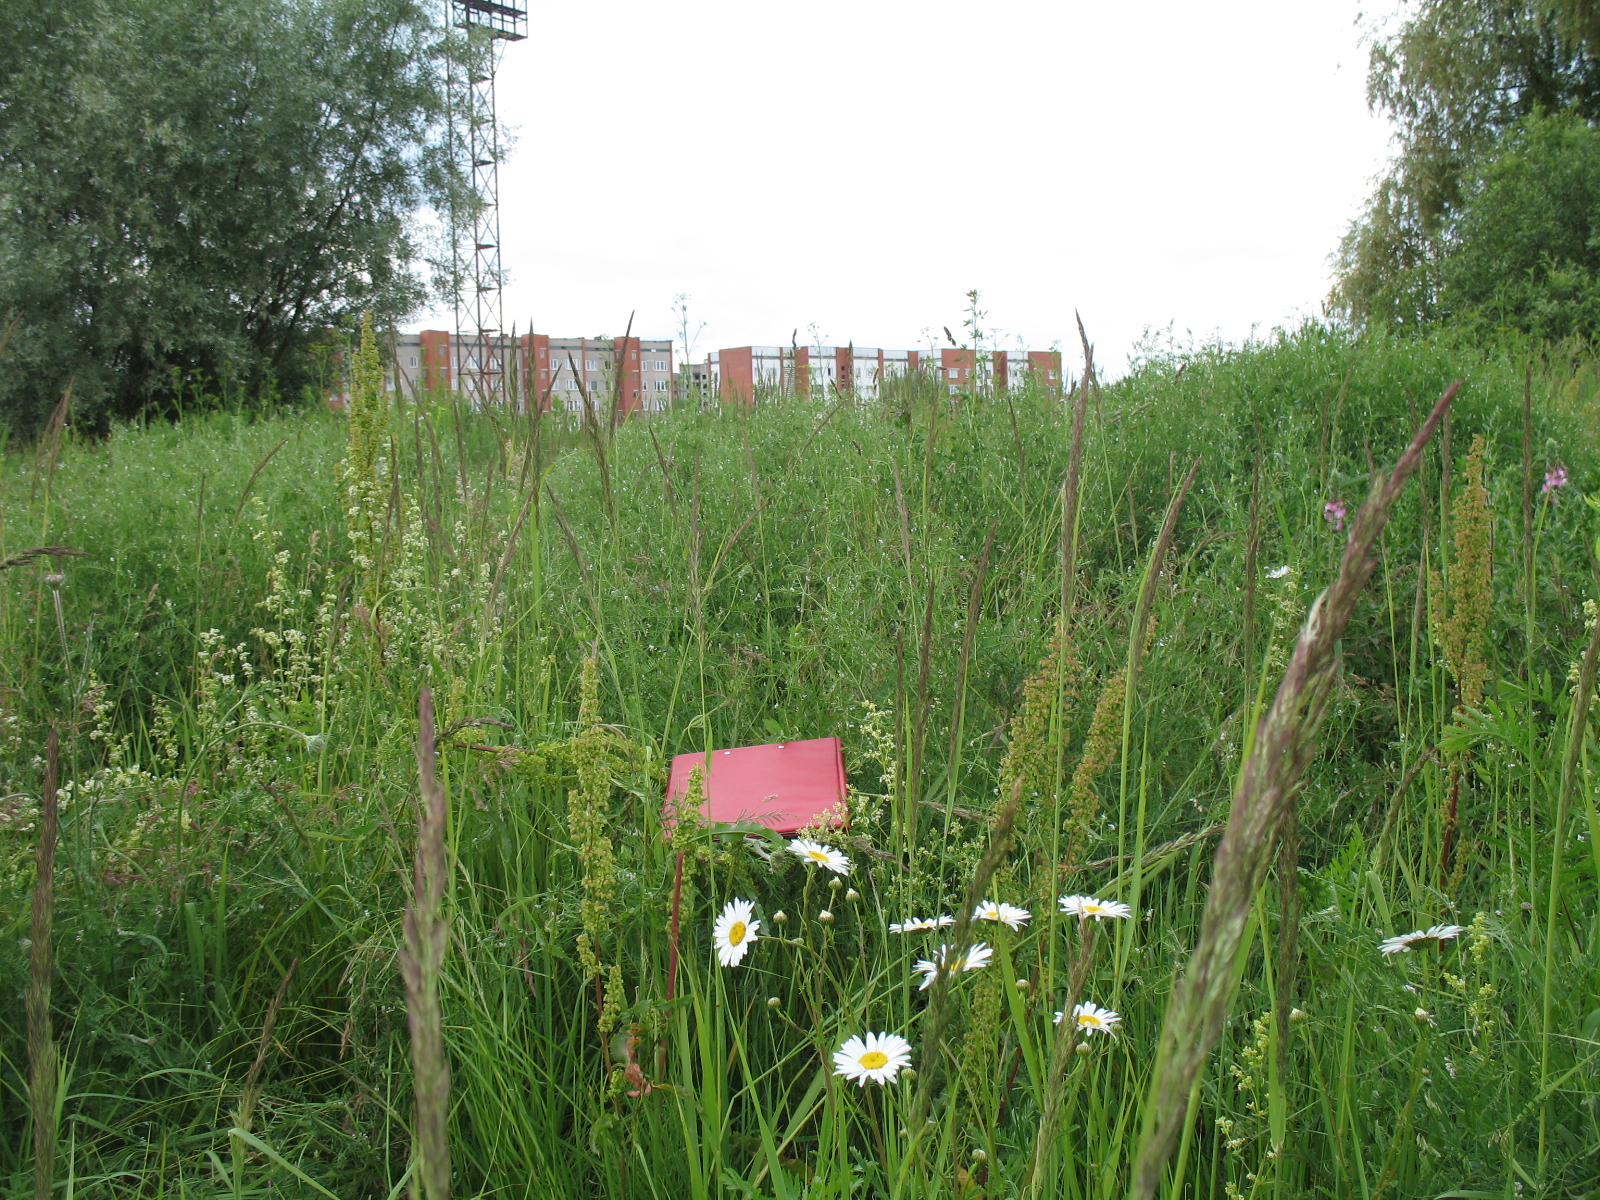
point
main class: Grassland
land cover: Grassland without tree/shrub cover
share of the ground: > 75 %
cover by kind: herbaceous plants 100 %
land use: Abandoned areas
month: June
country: LV
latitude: 56.6650
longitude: 23.7690
